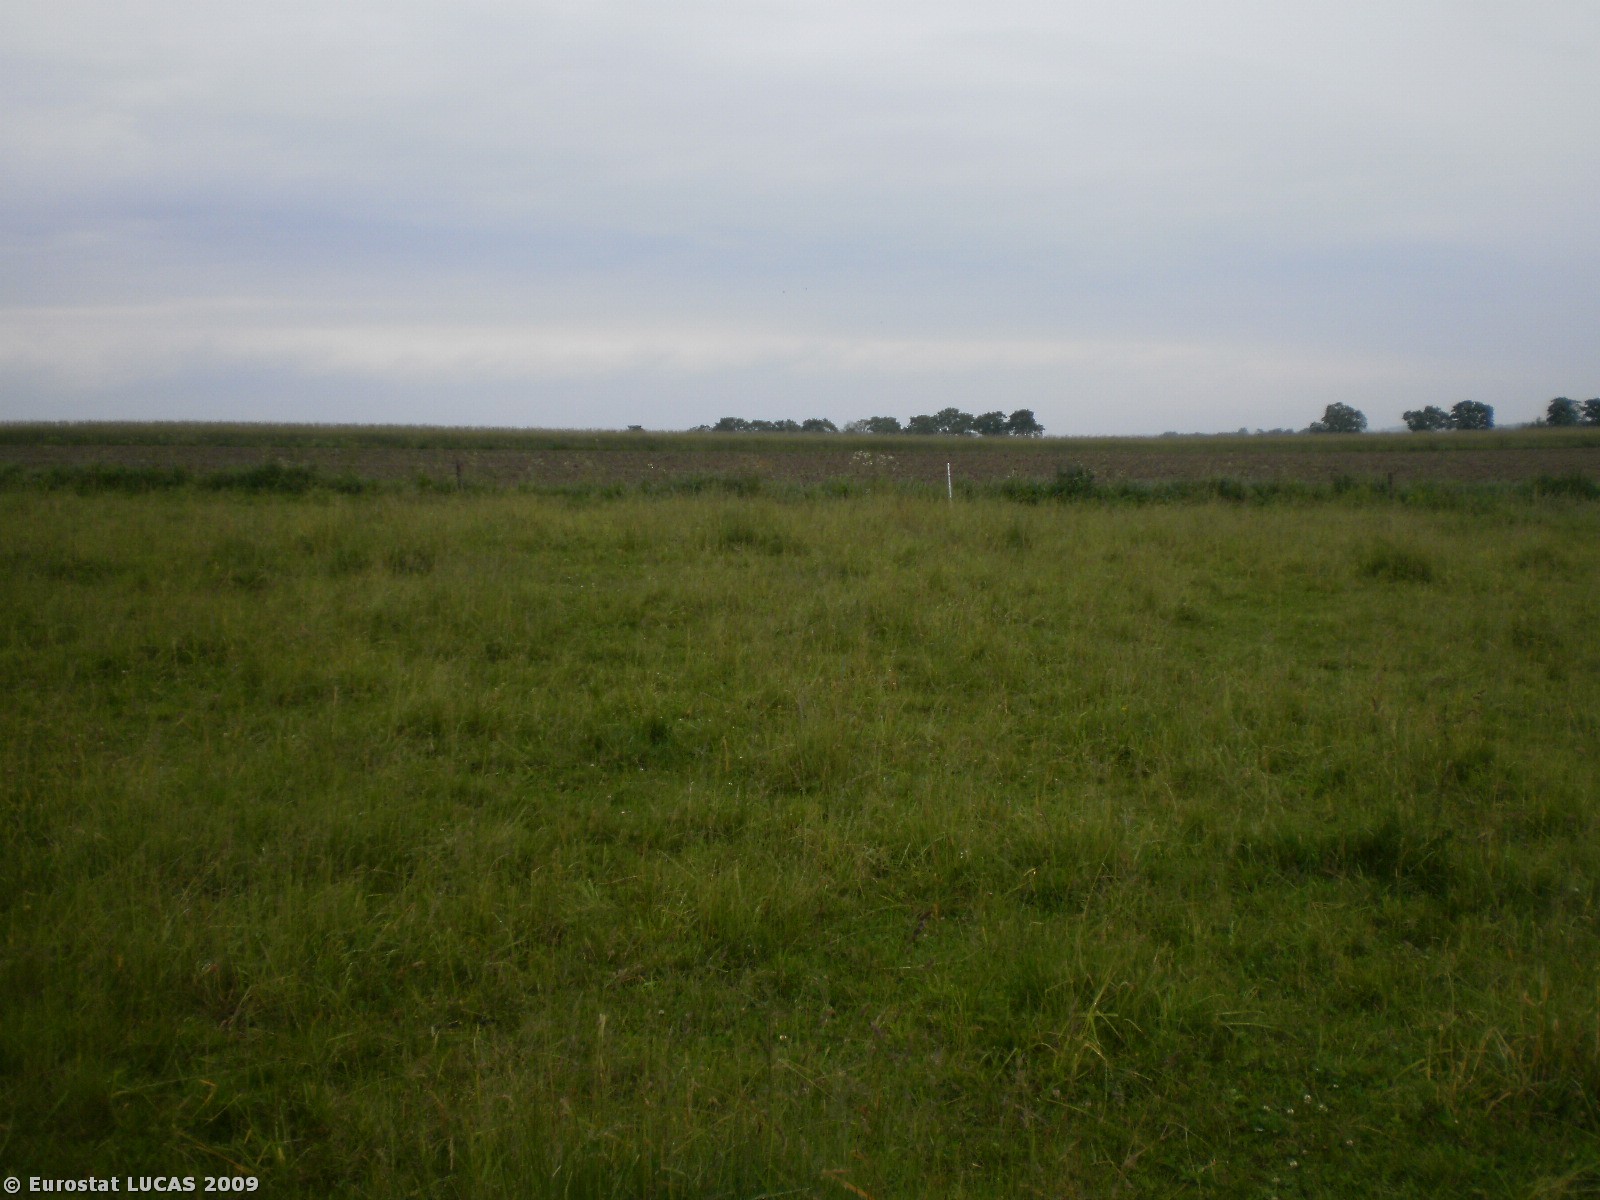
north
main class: Grassland
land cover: Grassland without tree/shrub cover
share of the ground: > 75 %
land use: Agriculture (excluding fallow land and kitchen gardens)
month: June
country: PL
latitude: 53.5935
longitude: 19.8965
